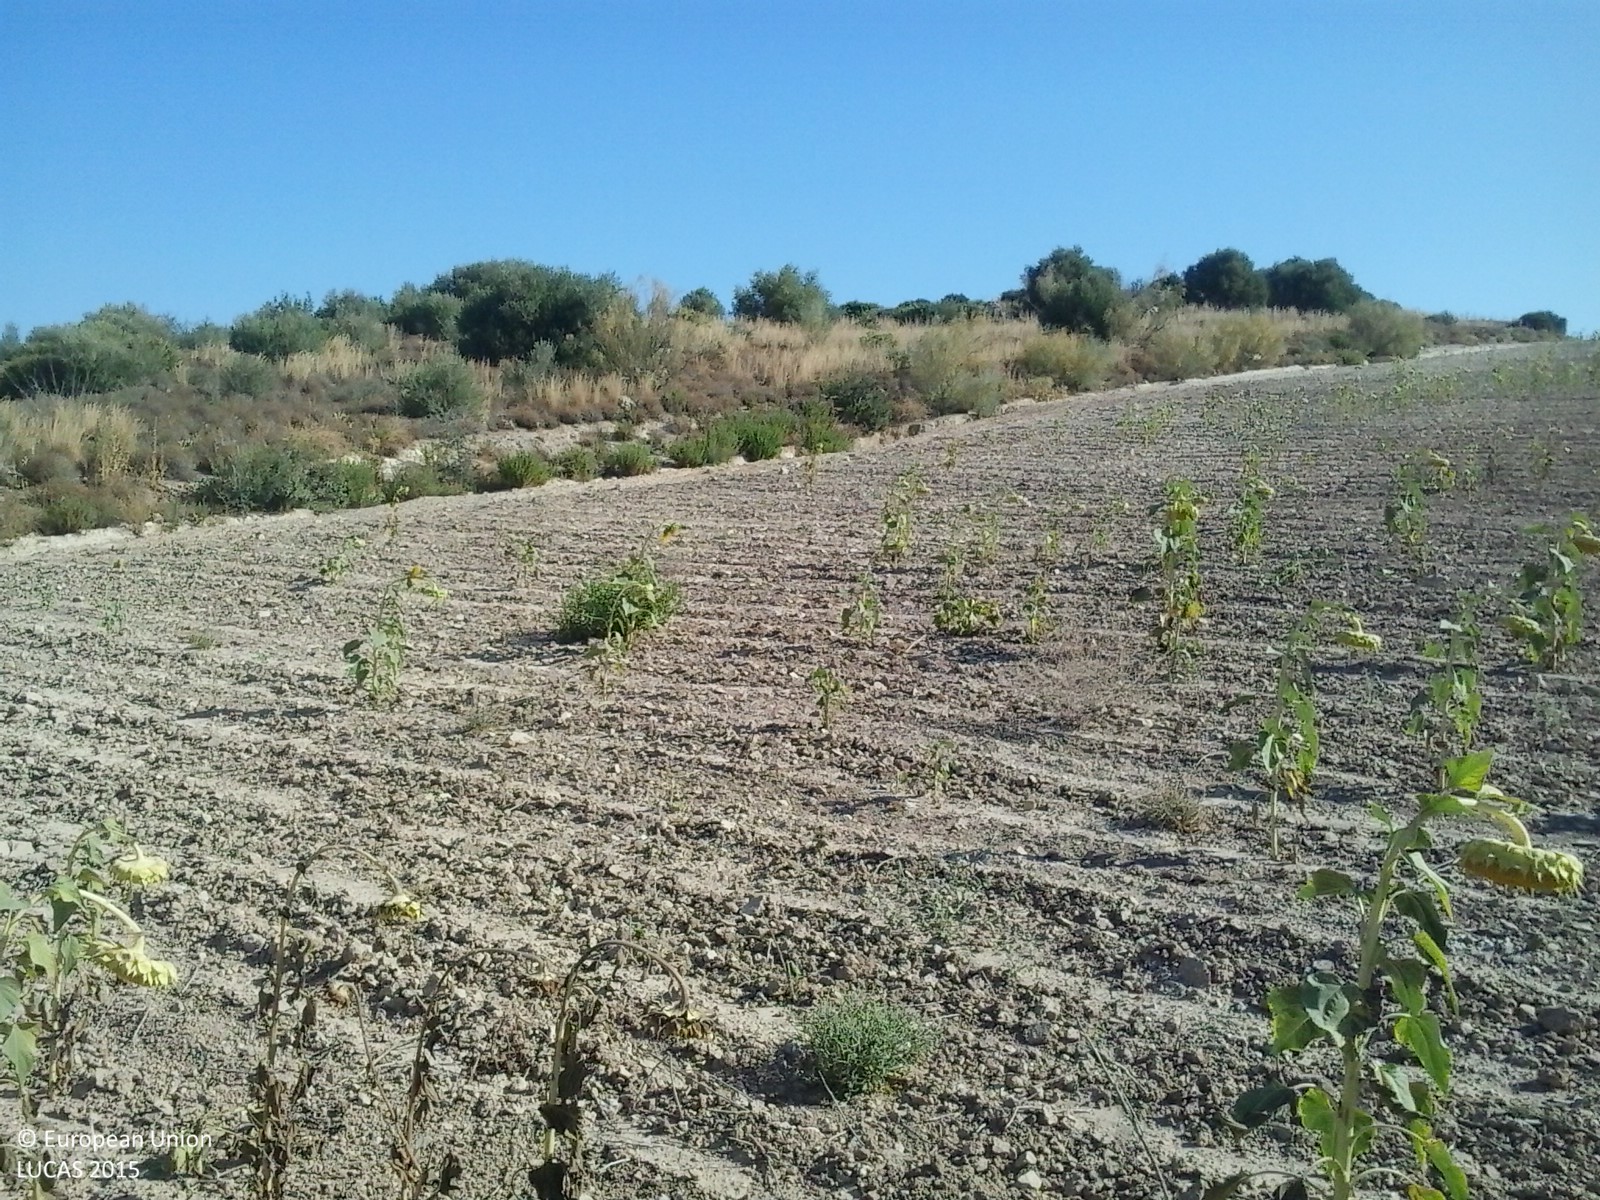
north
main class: Cropland
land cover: Sunflower
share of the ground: 10 - 25 %
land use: Agriculture (excluding fallow land and kitchen gardens)
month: July
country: ES
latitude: 36.8670
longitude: -5.9758
